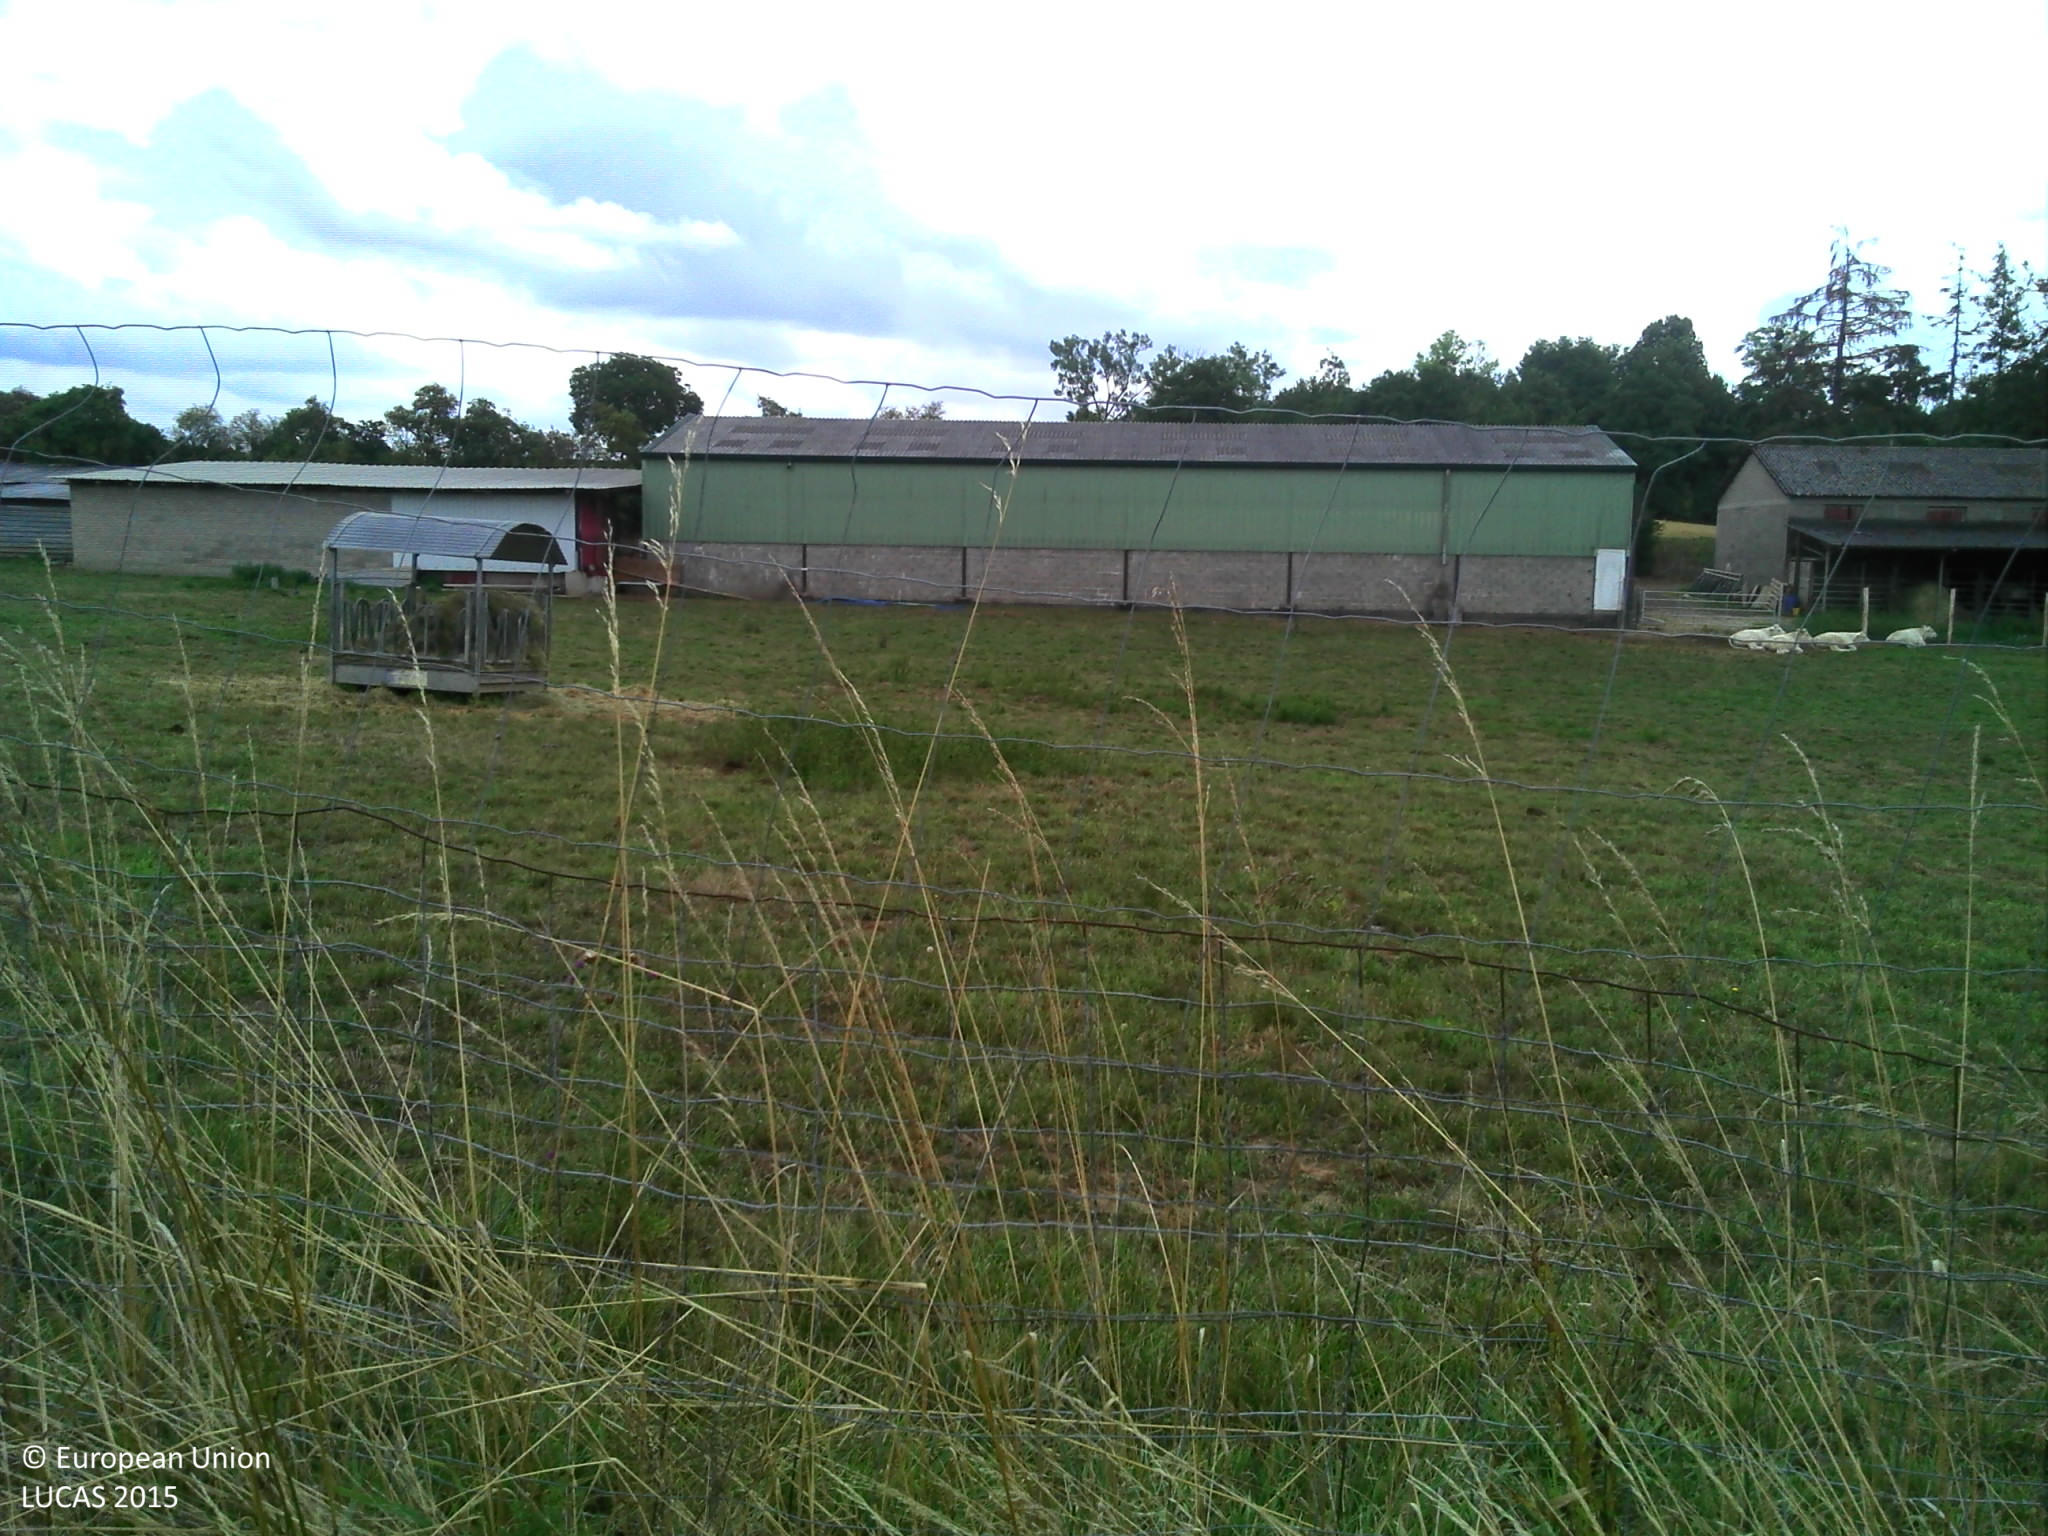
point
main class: Grassland
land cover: Grassland without tree/shrub cover
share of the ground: > 75 %
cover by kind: herbaceous plants 100 %
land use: Agriculture (excluding fallow land and kitchen gardens)
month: August
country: FR
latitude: 48.7402
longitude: 7.7299
